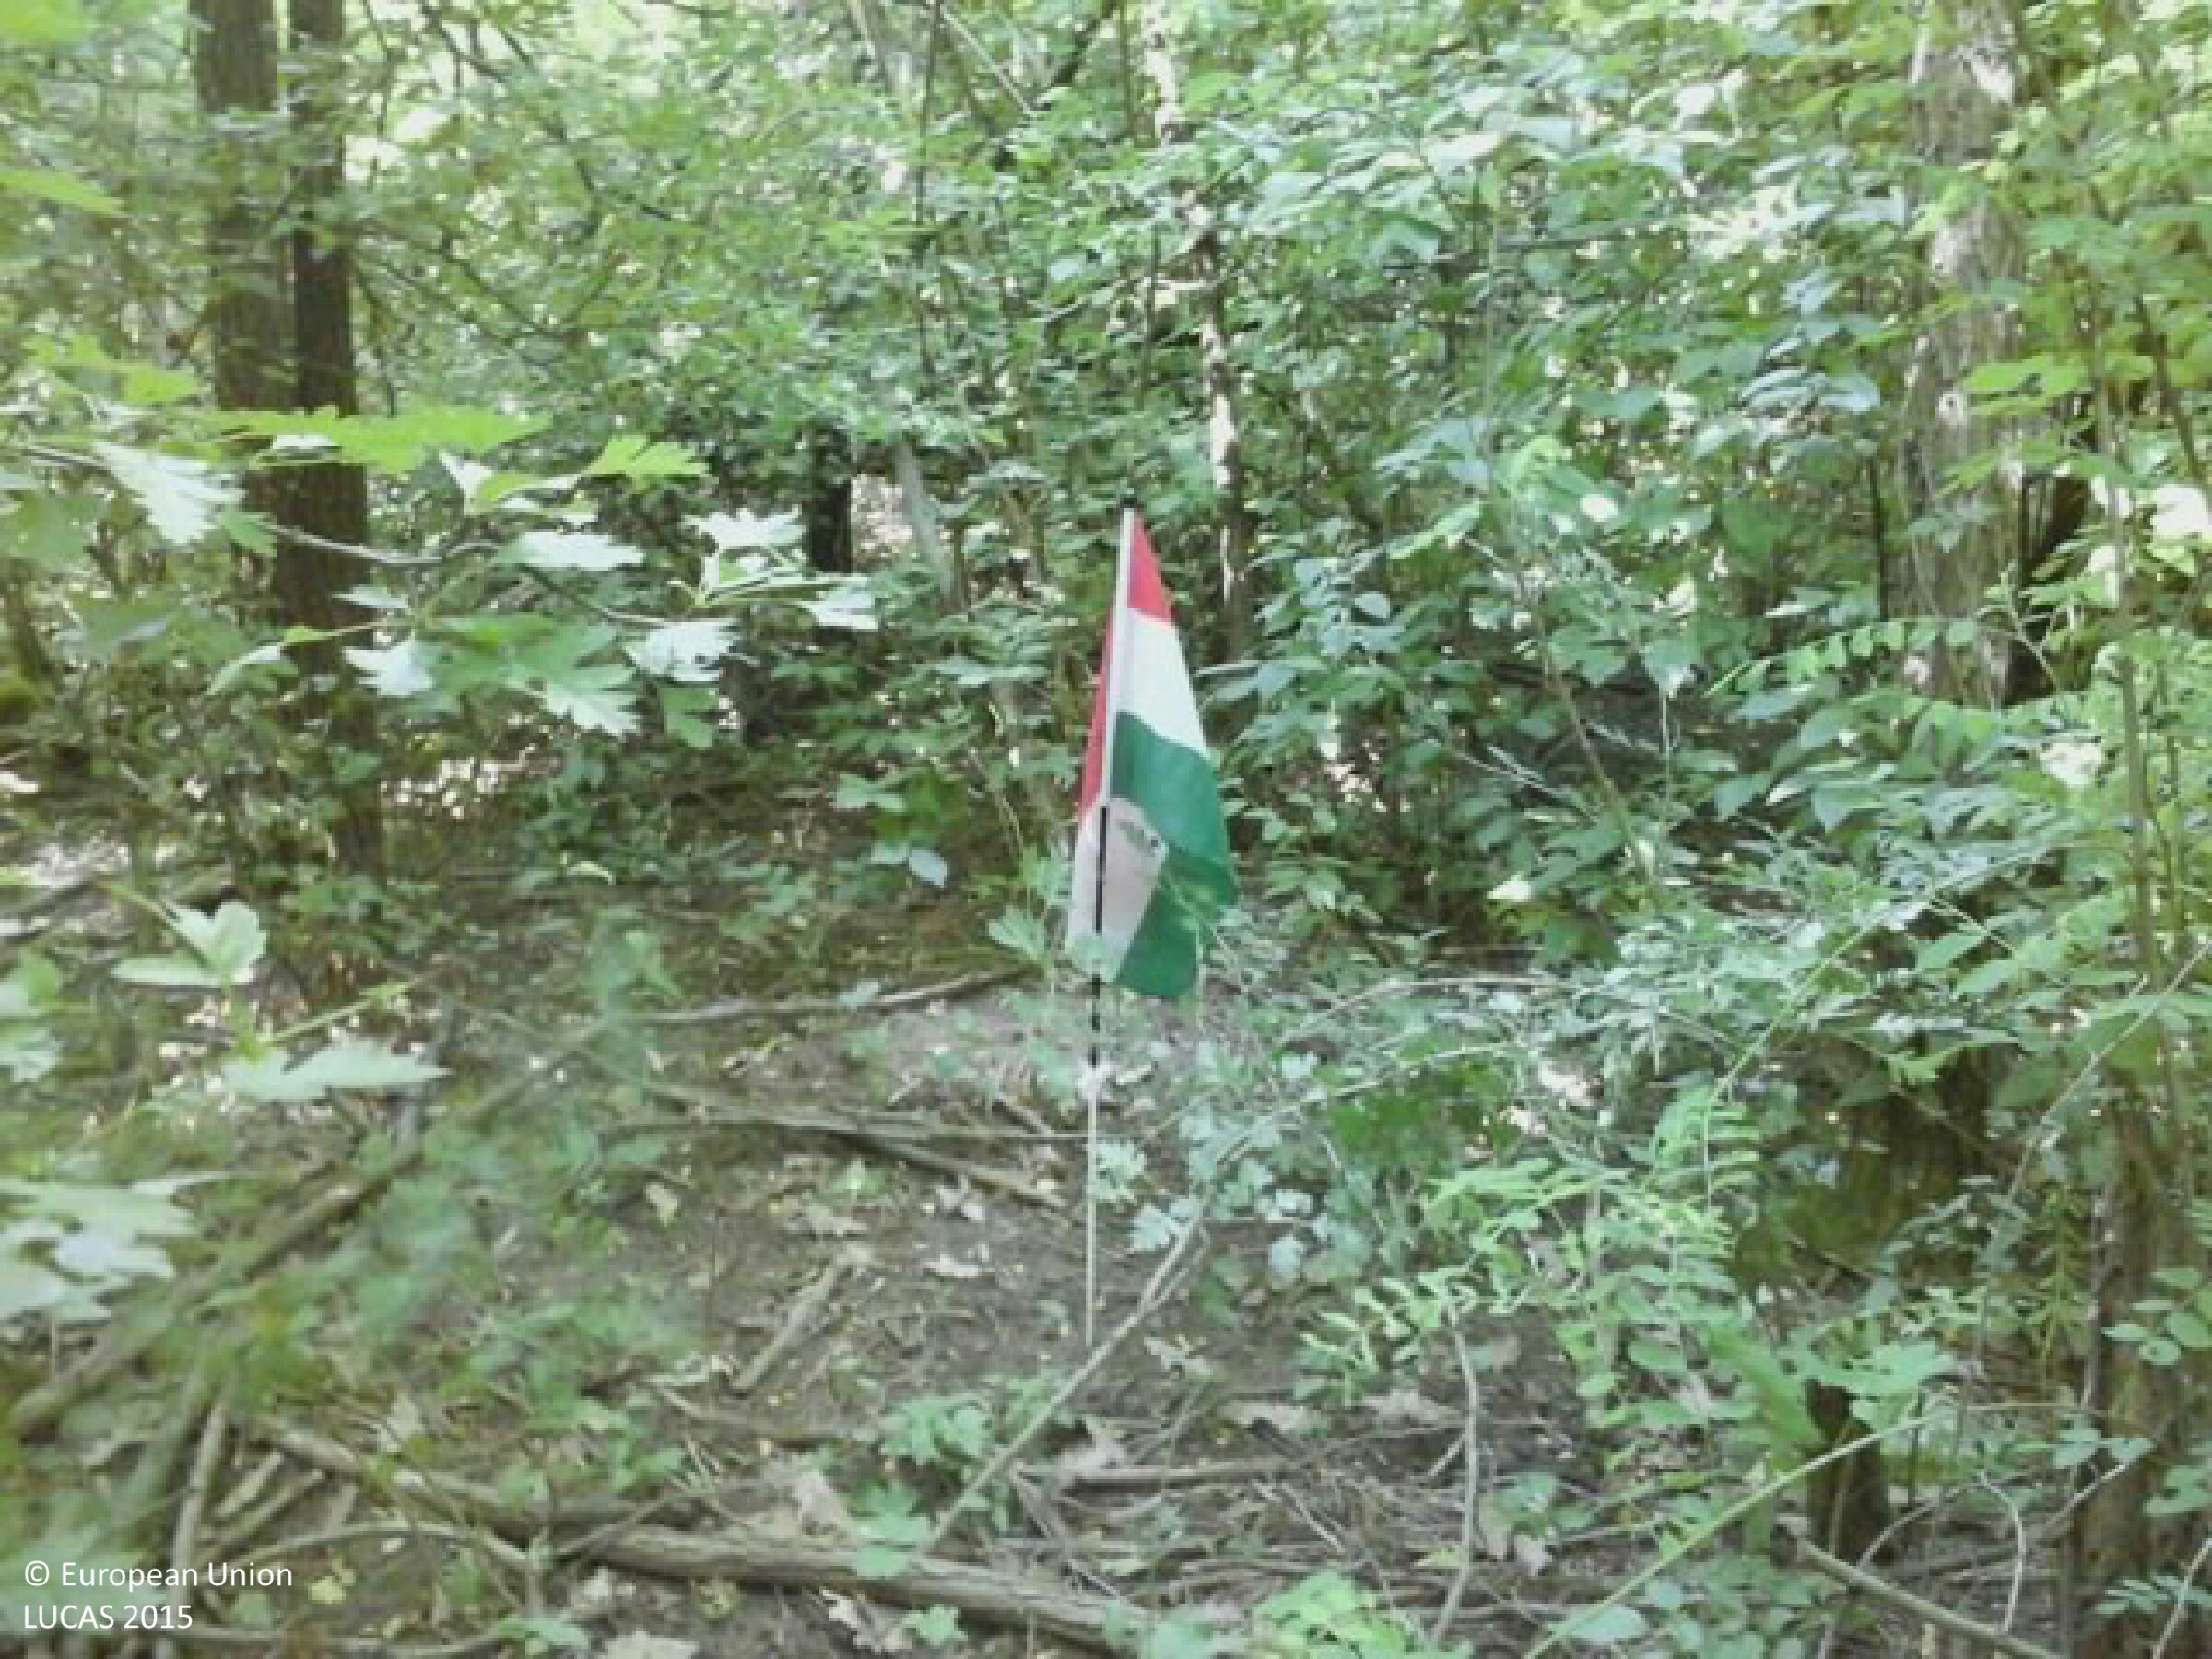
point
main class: Woodland
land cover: Broadleaved woodland
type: mesophytic deciduous forest
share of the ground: > 75 %
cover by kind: broadleaved forest trees 95 %, shrubs 5 %
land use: Forestry
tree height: > 5 m
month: July
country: HU
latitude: 47.6843
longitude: 19.3058
